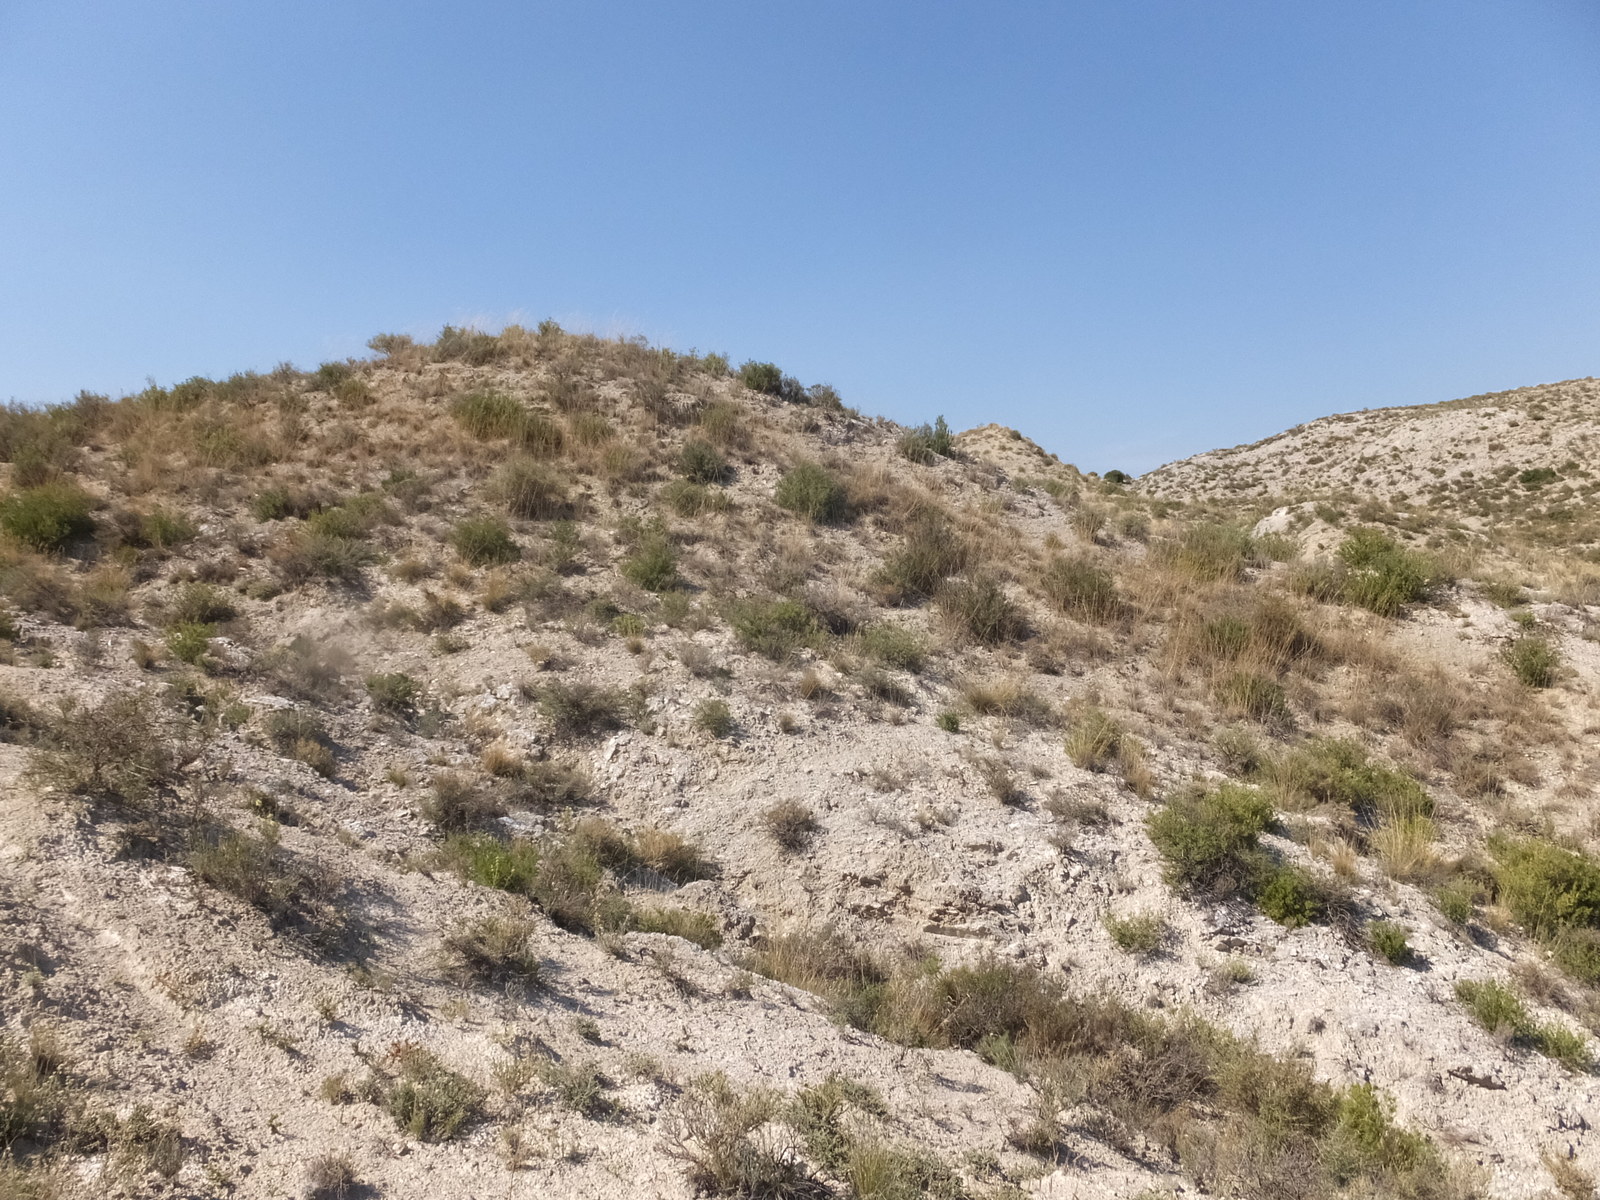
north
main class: Shrubland
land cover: Shrubland without tree cover
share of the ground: 50 - 75 %
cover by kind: shrubs 50 %, herbaceous plants 25 %, consolidated bare surface 25 %
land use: Semi-natural and natural areas not in use
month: June
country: ES
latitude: 41.8460
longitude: 0.5311
